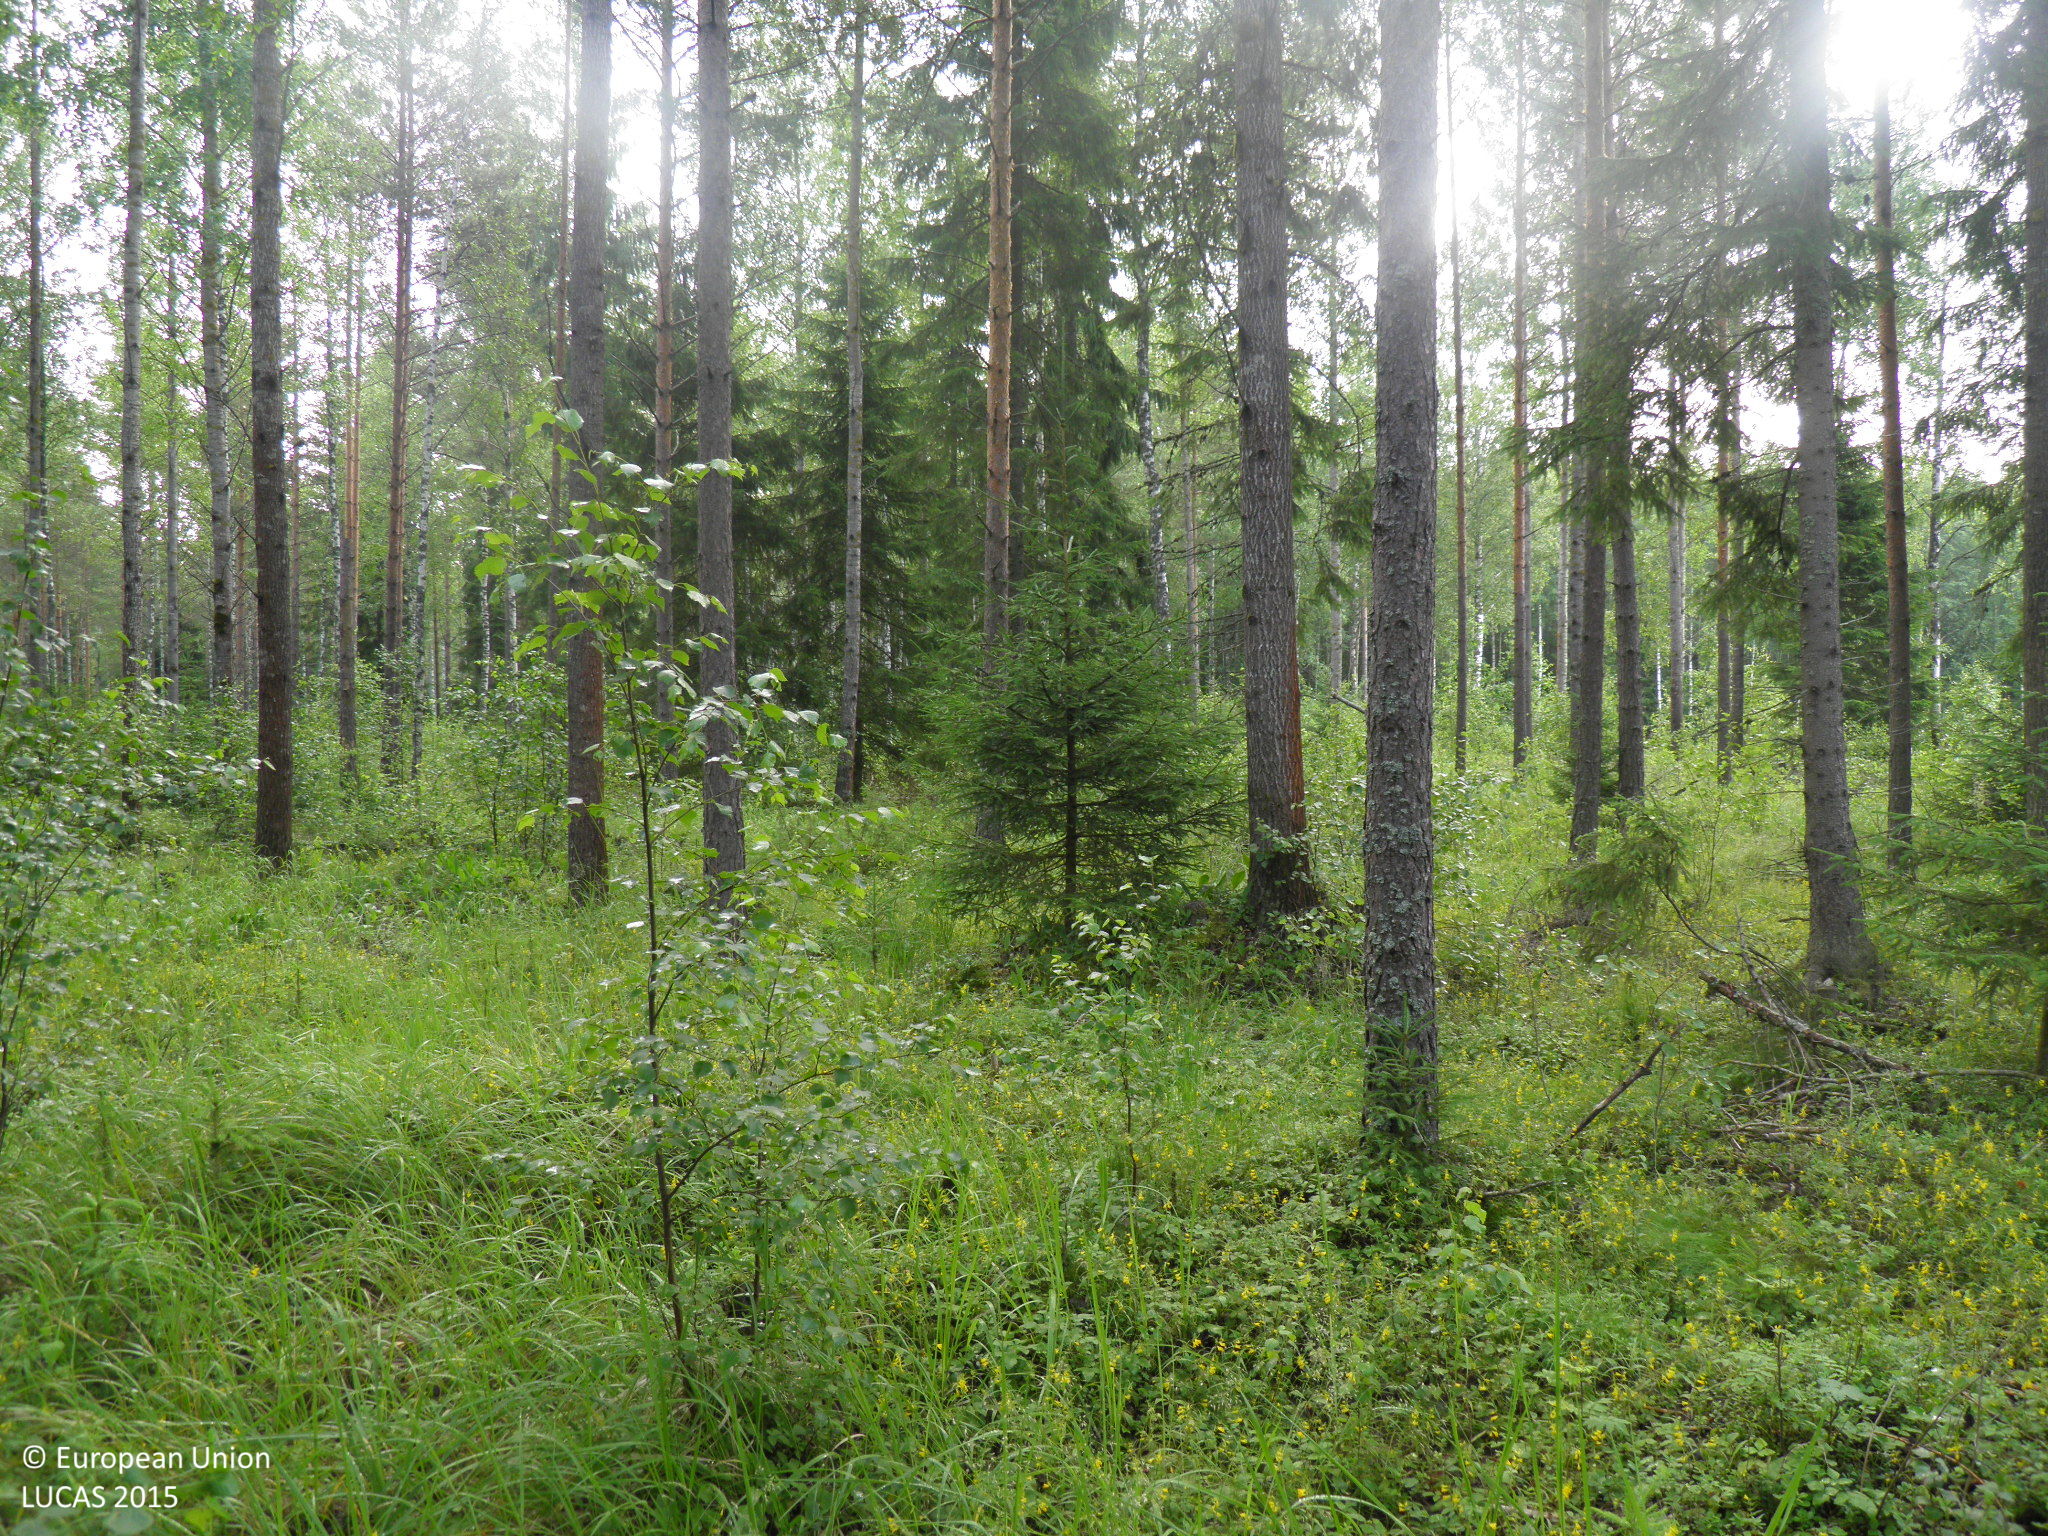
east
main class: Woodland
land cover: Other mixed woodland
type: hemiboreal forest and nemoral coniferous forest and mixed broadleaved-coniferous forest
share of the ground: 50 - 75 %
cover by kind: broadleaved forest trees 40 %, coniferous forest trees 20 %, shrubs 20 %, herbaceous plants 20 %
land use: Forestry
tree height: > 5 m
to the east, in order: Other mixed woodland; Broadleaved woodland; Ditches and canals; Spruce dominated mixed woodland; Ditches and canals; Grass margins; Tracks; Grass margins; Ditches and canals; Pine dominated mixed woodland; Pine dominated coniferous woodland
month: July
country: FI
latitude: 60.6699
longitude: 22.4214
